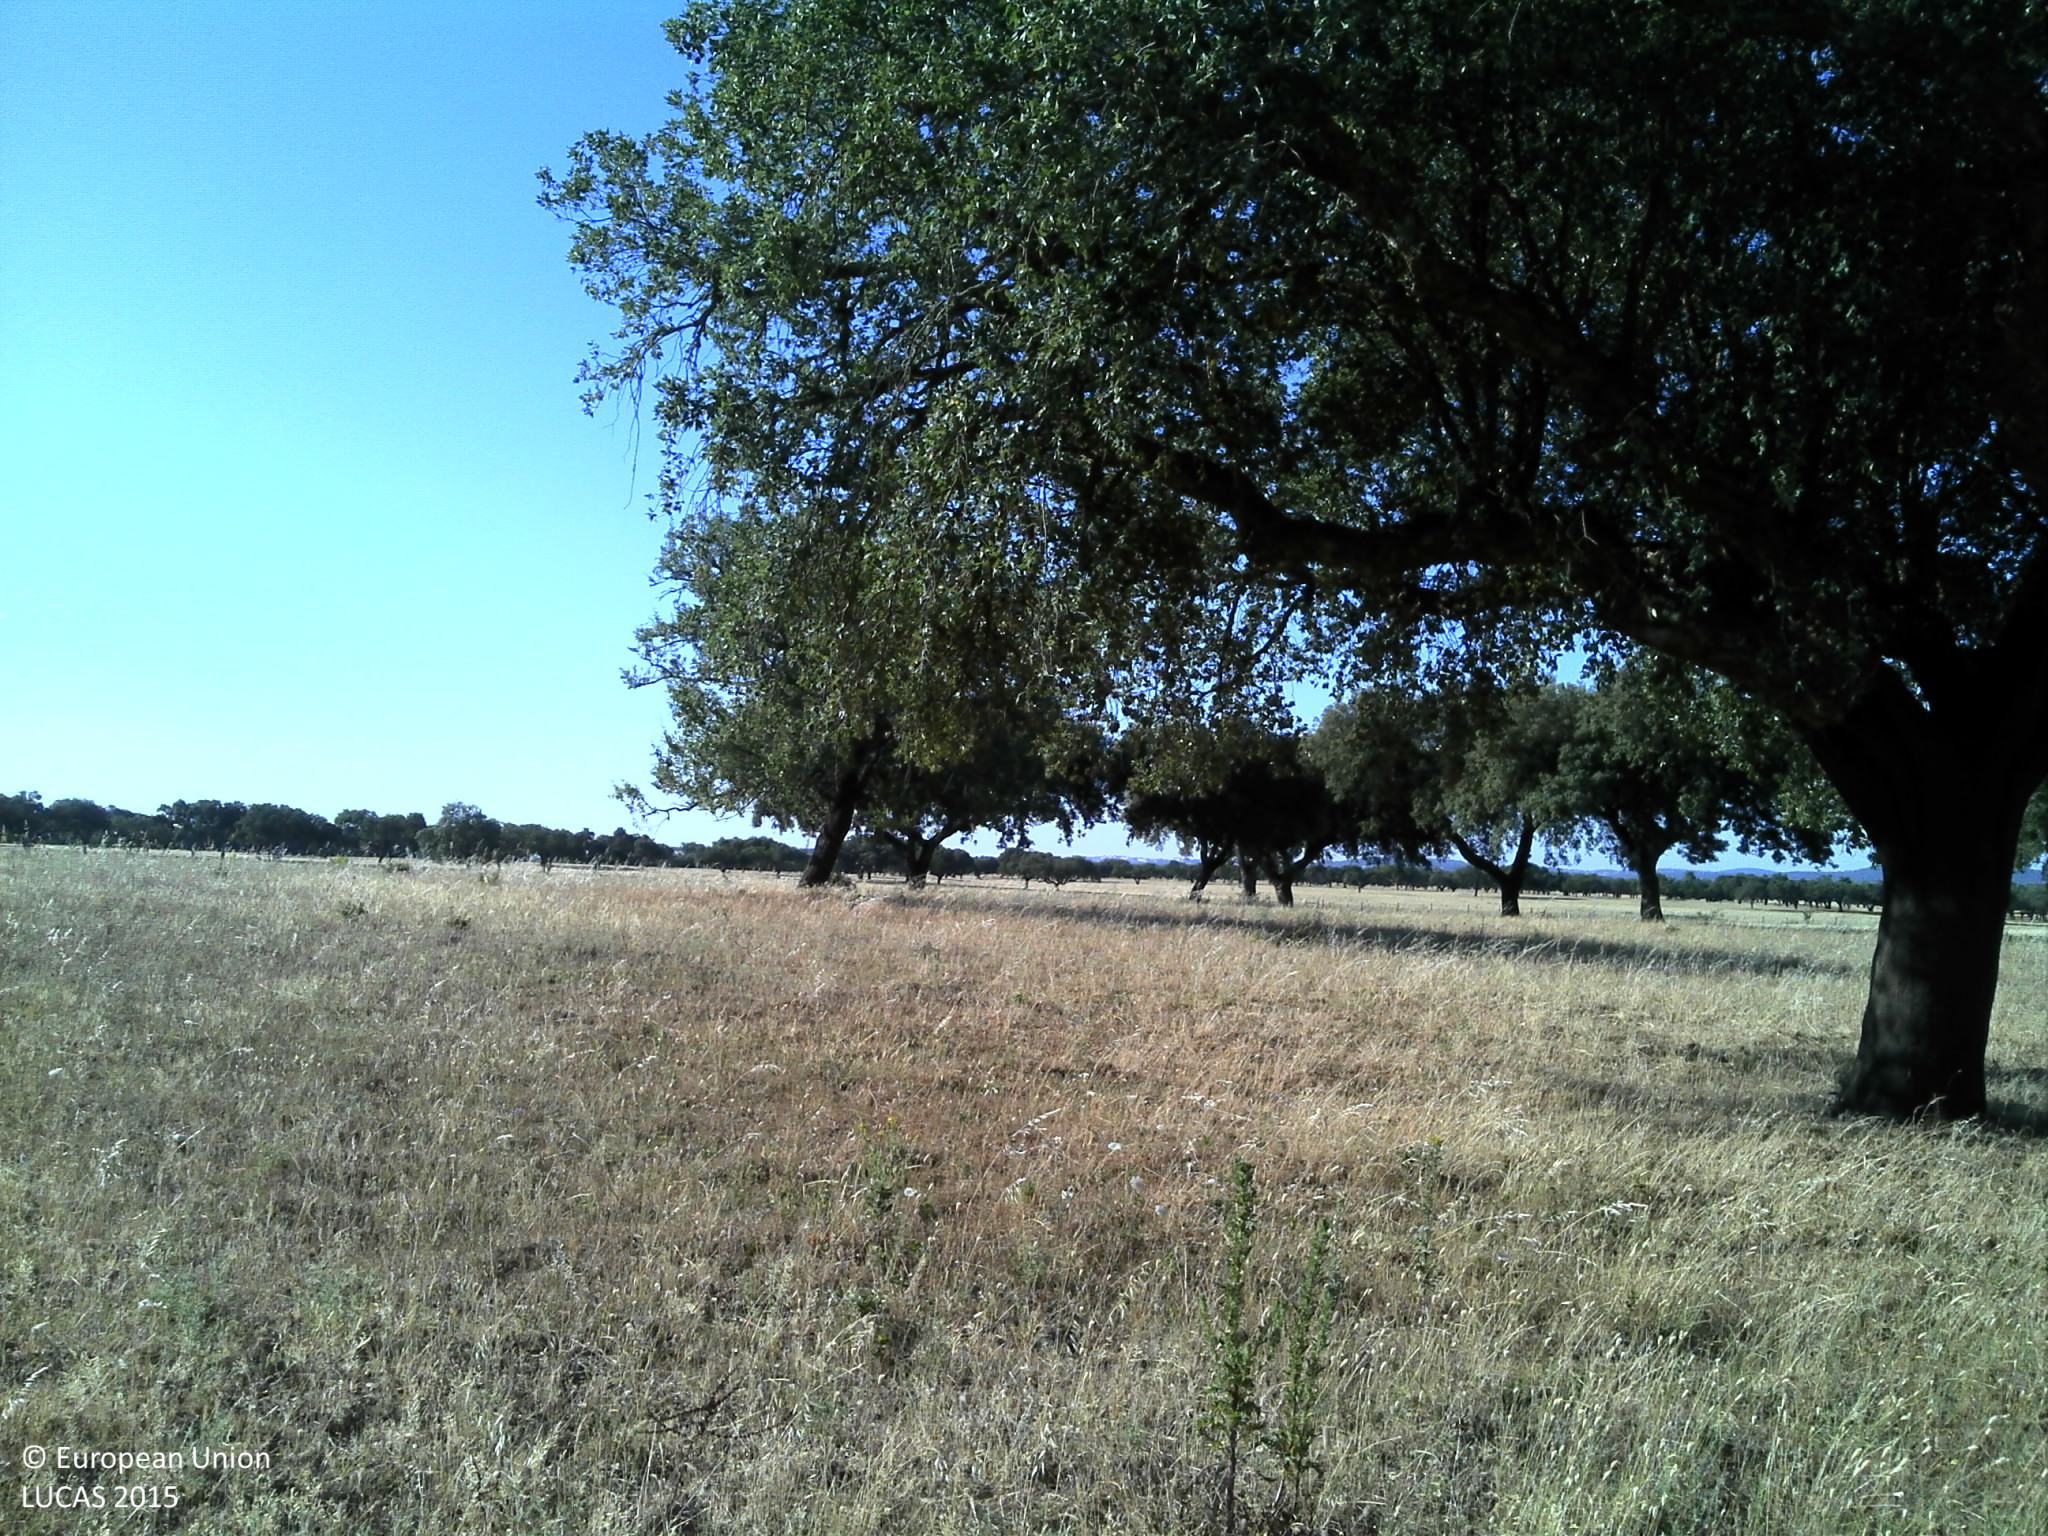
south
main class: Woodland
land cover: Broadleaved woodland
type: broadleaved evergreen forest
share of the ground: 10 - 25 %
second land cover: Grassland without tree/shrub cover
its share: 25 - 50 %
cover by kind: unconsolidated bare surface 75 %, herbaceous plants 15 %, broadleaved forest trees 10 %
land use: Forestry
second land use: Agriculture (excluding fallow land and kitchen gardens)
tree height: > 5 m
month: June
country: PT
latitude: 38.4766
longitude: -8.1901
